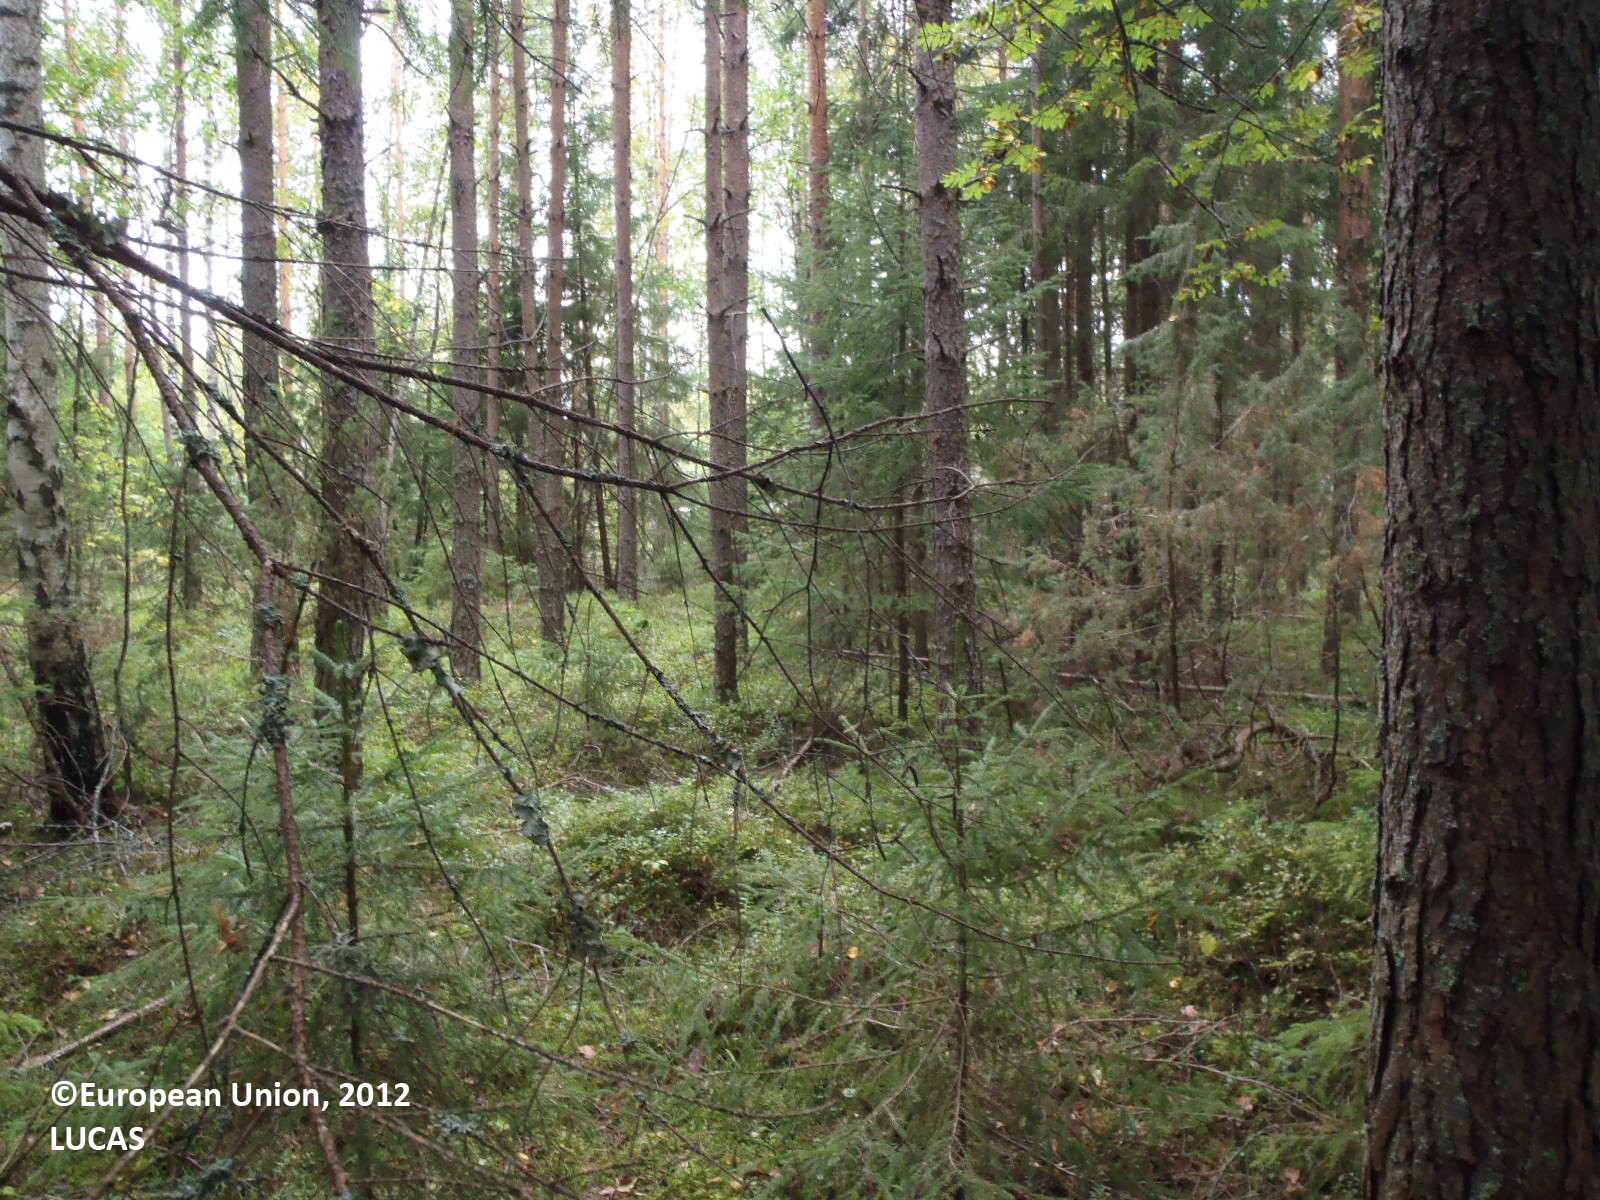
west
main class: Woodland
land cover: Pine dominated mixed woodland
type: boreal forest
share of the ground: > 75 %
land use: Forestry
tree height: > 5 m
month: September
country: FI
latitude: 60.7439
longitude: 22.8223
